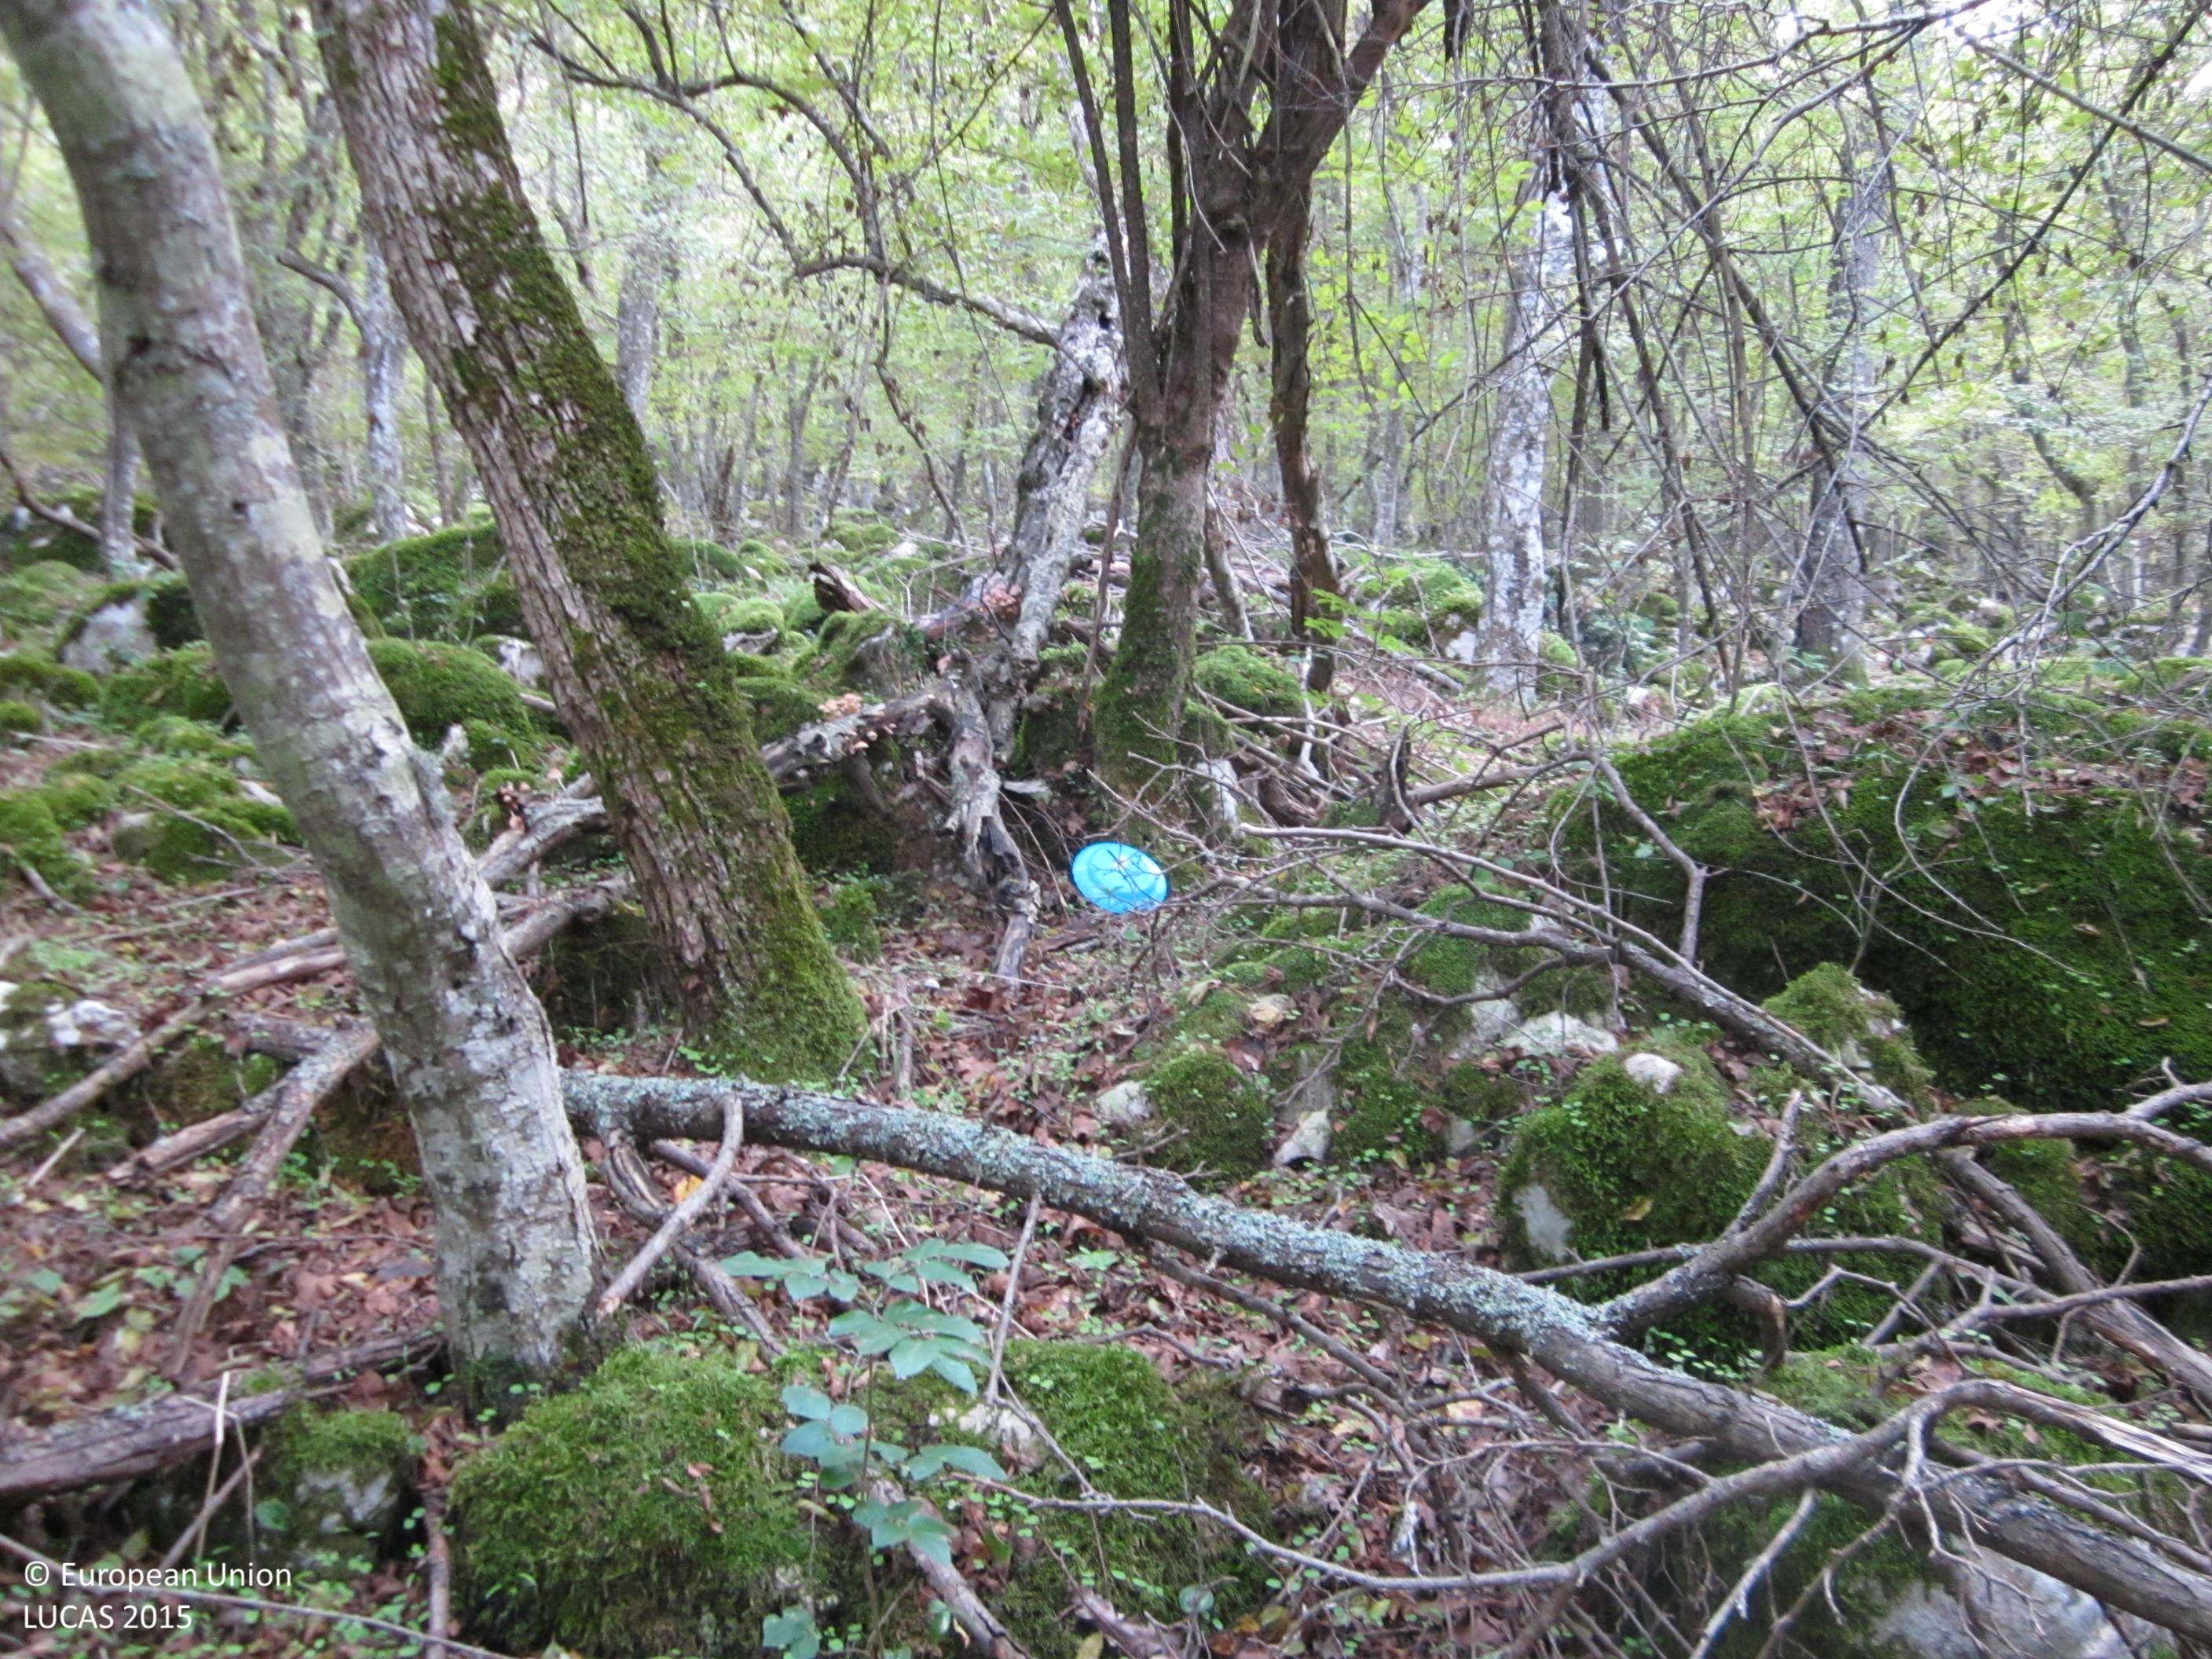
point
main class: Woodland
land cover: Broadleaved woodland
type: mesophytic deciduous forest
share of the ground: > 75 %
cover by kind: broadleaved forest trees 90 %, lichens and mosses 5 %, unconsolidated bare surface 5 %
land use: Forestry
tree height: > 5 m
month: October
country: BG
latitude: 42.2116
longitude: 27.2469
